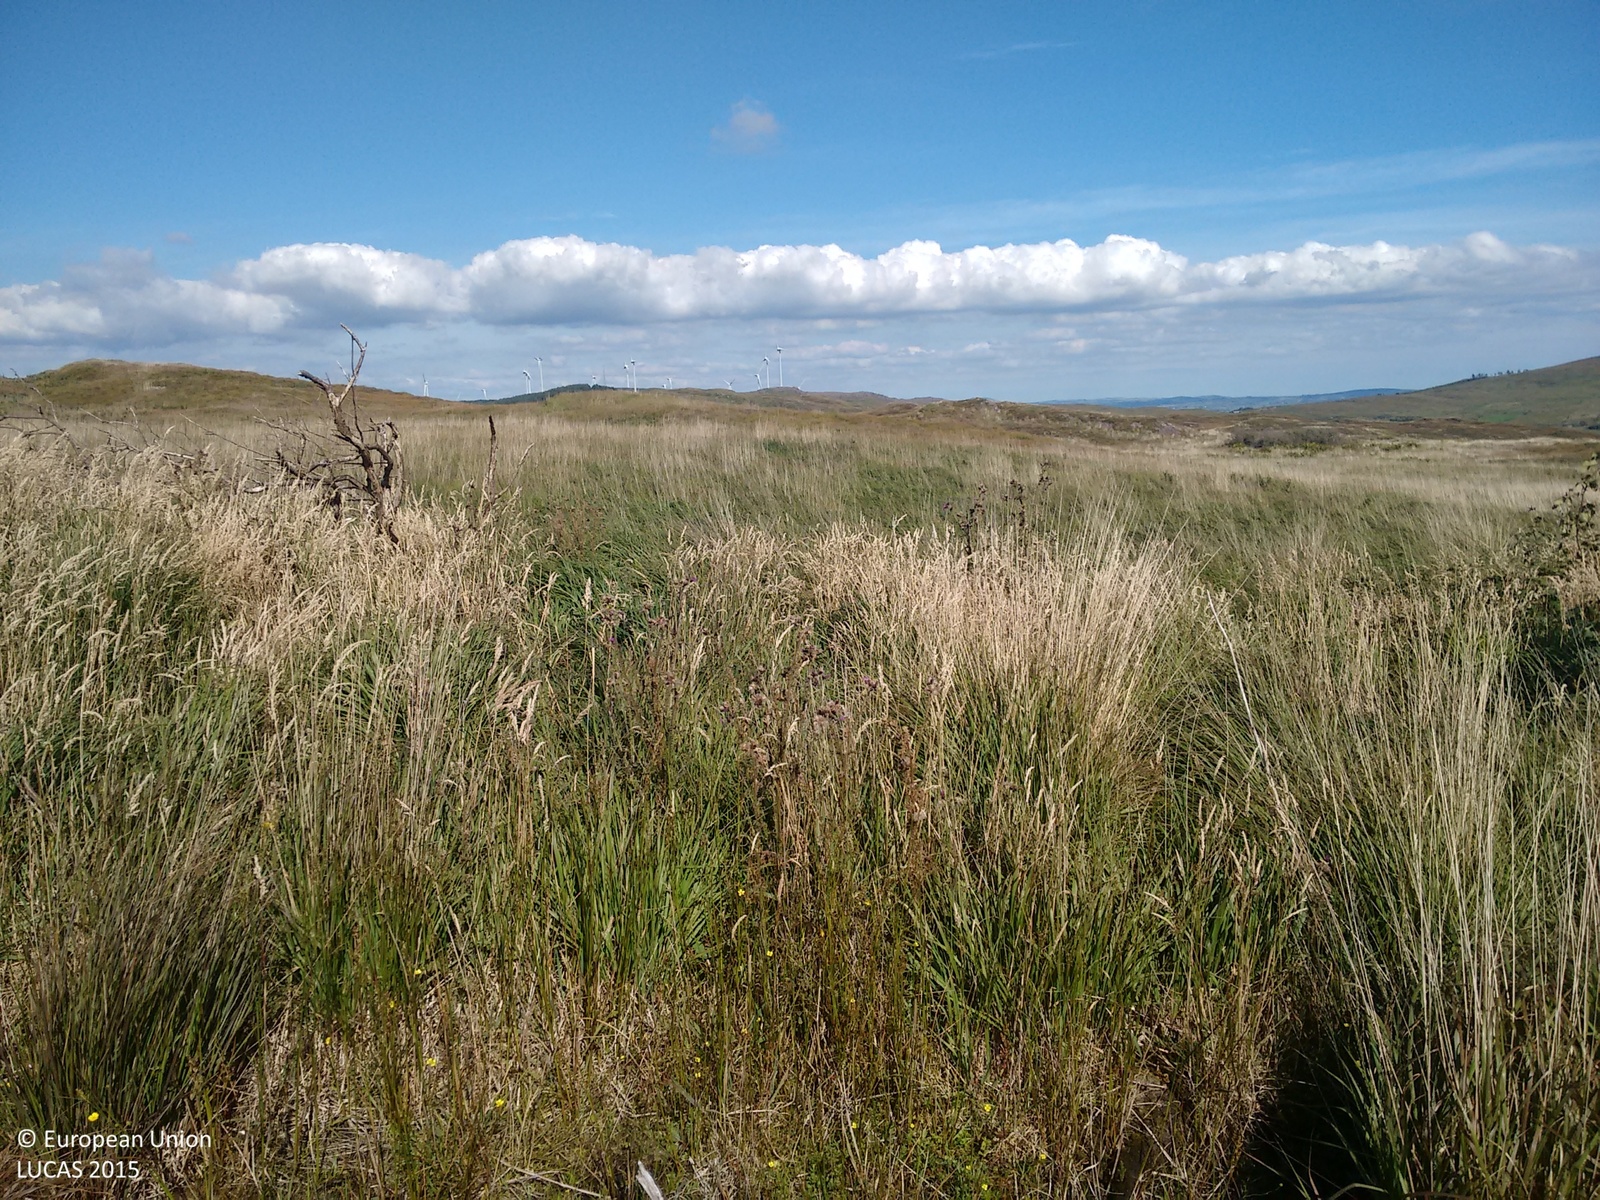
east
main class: Grassland
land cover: Spontaneously vegetated surfaces
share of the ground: > 75 %
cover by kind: herbaceous plants 70 %, unconsolidated bare surface 30 %
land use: Semi-natural and natural areas not in use
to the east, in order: Spontaneously vegetated surfaces; Grassland without tree/shrub cover; Grassland with sparse tree/shrub cover; Inland marshes; Grassland with sparse tree/shrub cover; Grassland without tree/shrub cover; Rock outcrops; Grassland without tree/shrub cover
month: August
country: IE
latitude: 51.6199
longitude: -9.4251
